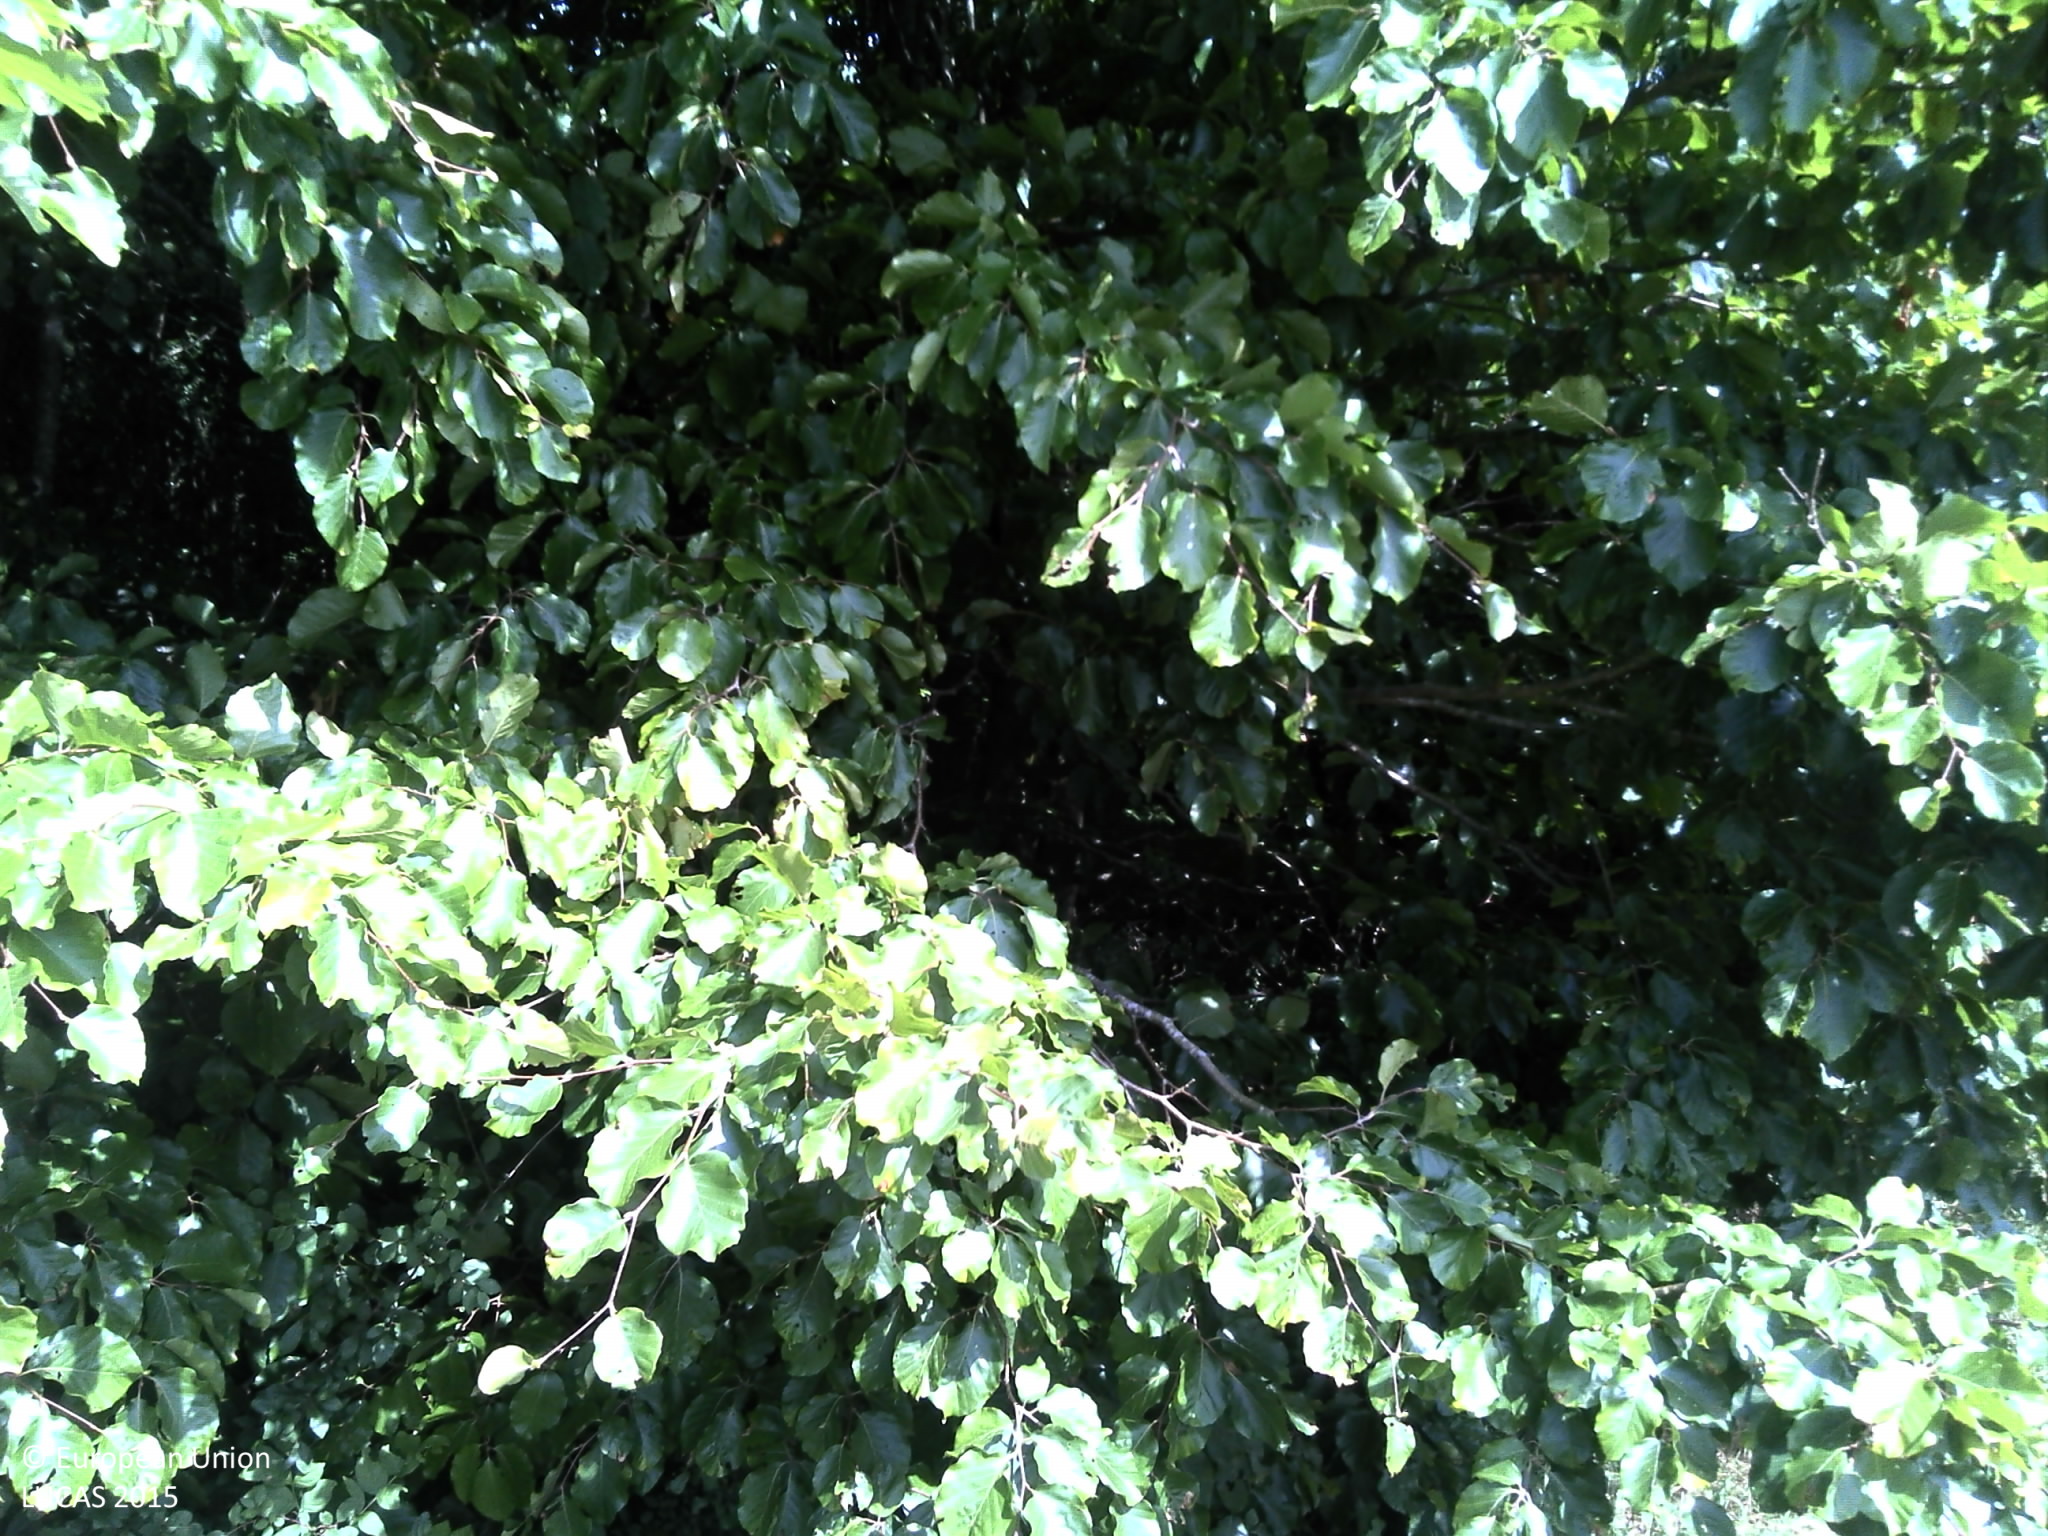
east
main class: Cropland
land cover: Rape and turnip rape
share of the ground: > 75 %
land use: Agriculture (excluding fallow land and kitchen gardens)
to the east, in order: Rape and turnip rape; Grass margins; Broadleaved woodland
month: June
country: FR
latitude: 49.3227
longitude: 6.0233
